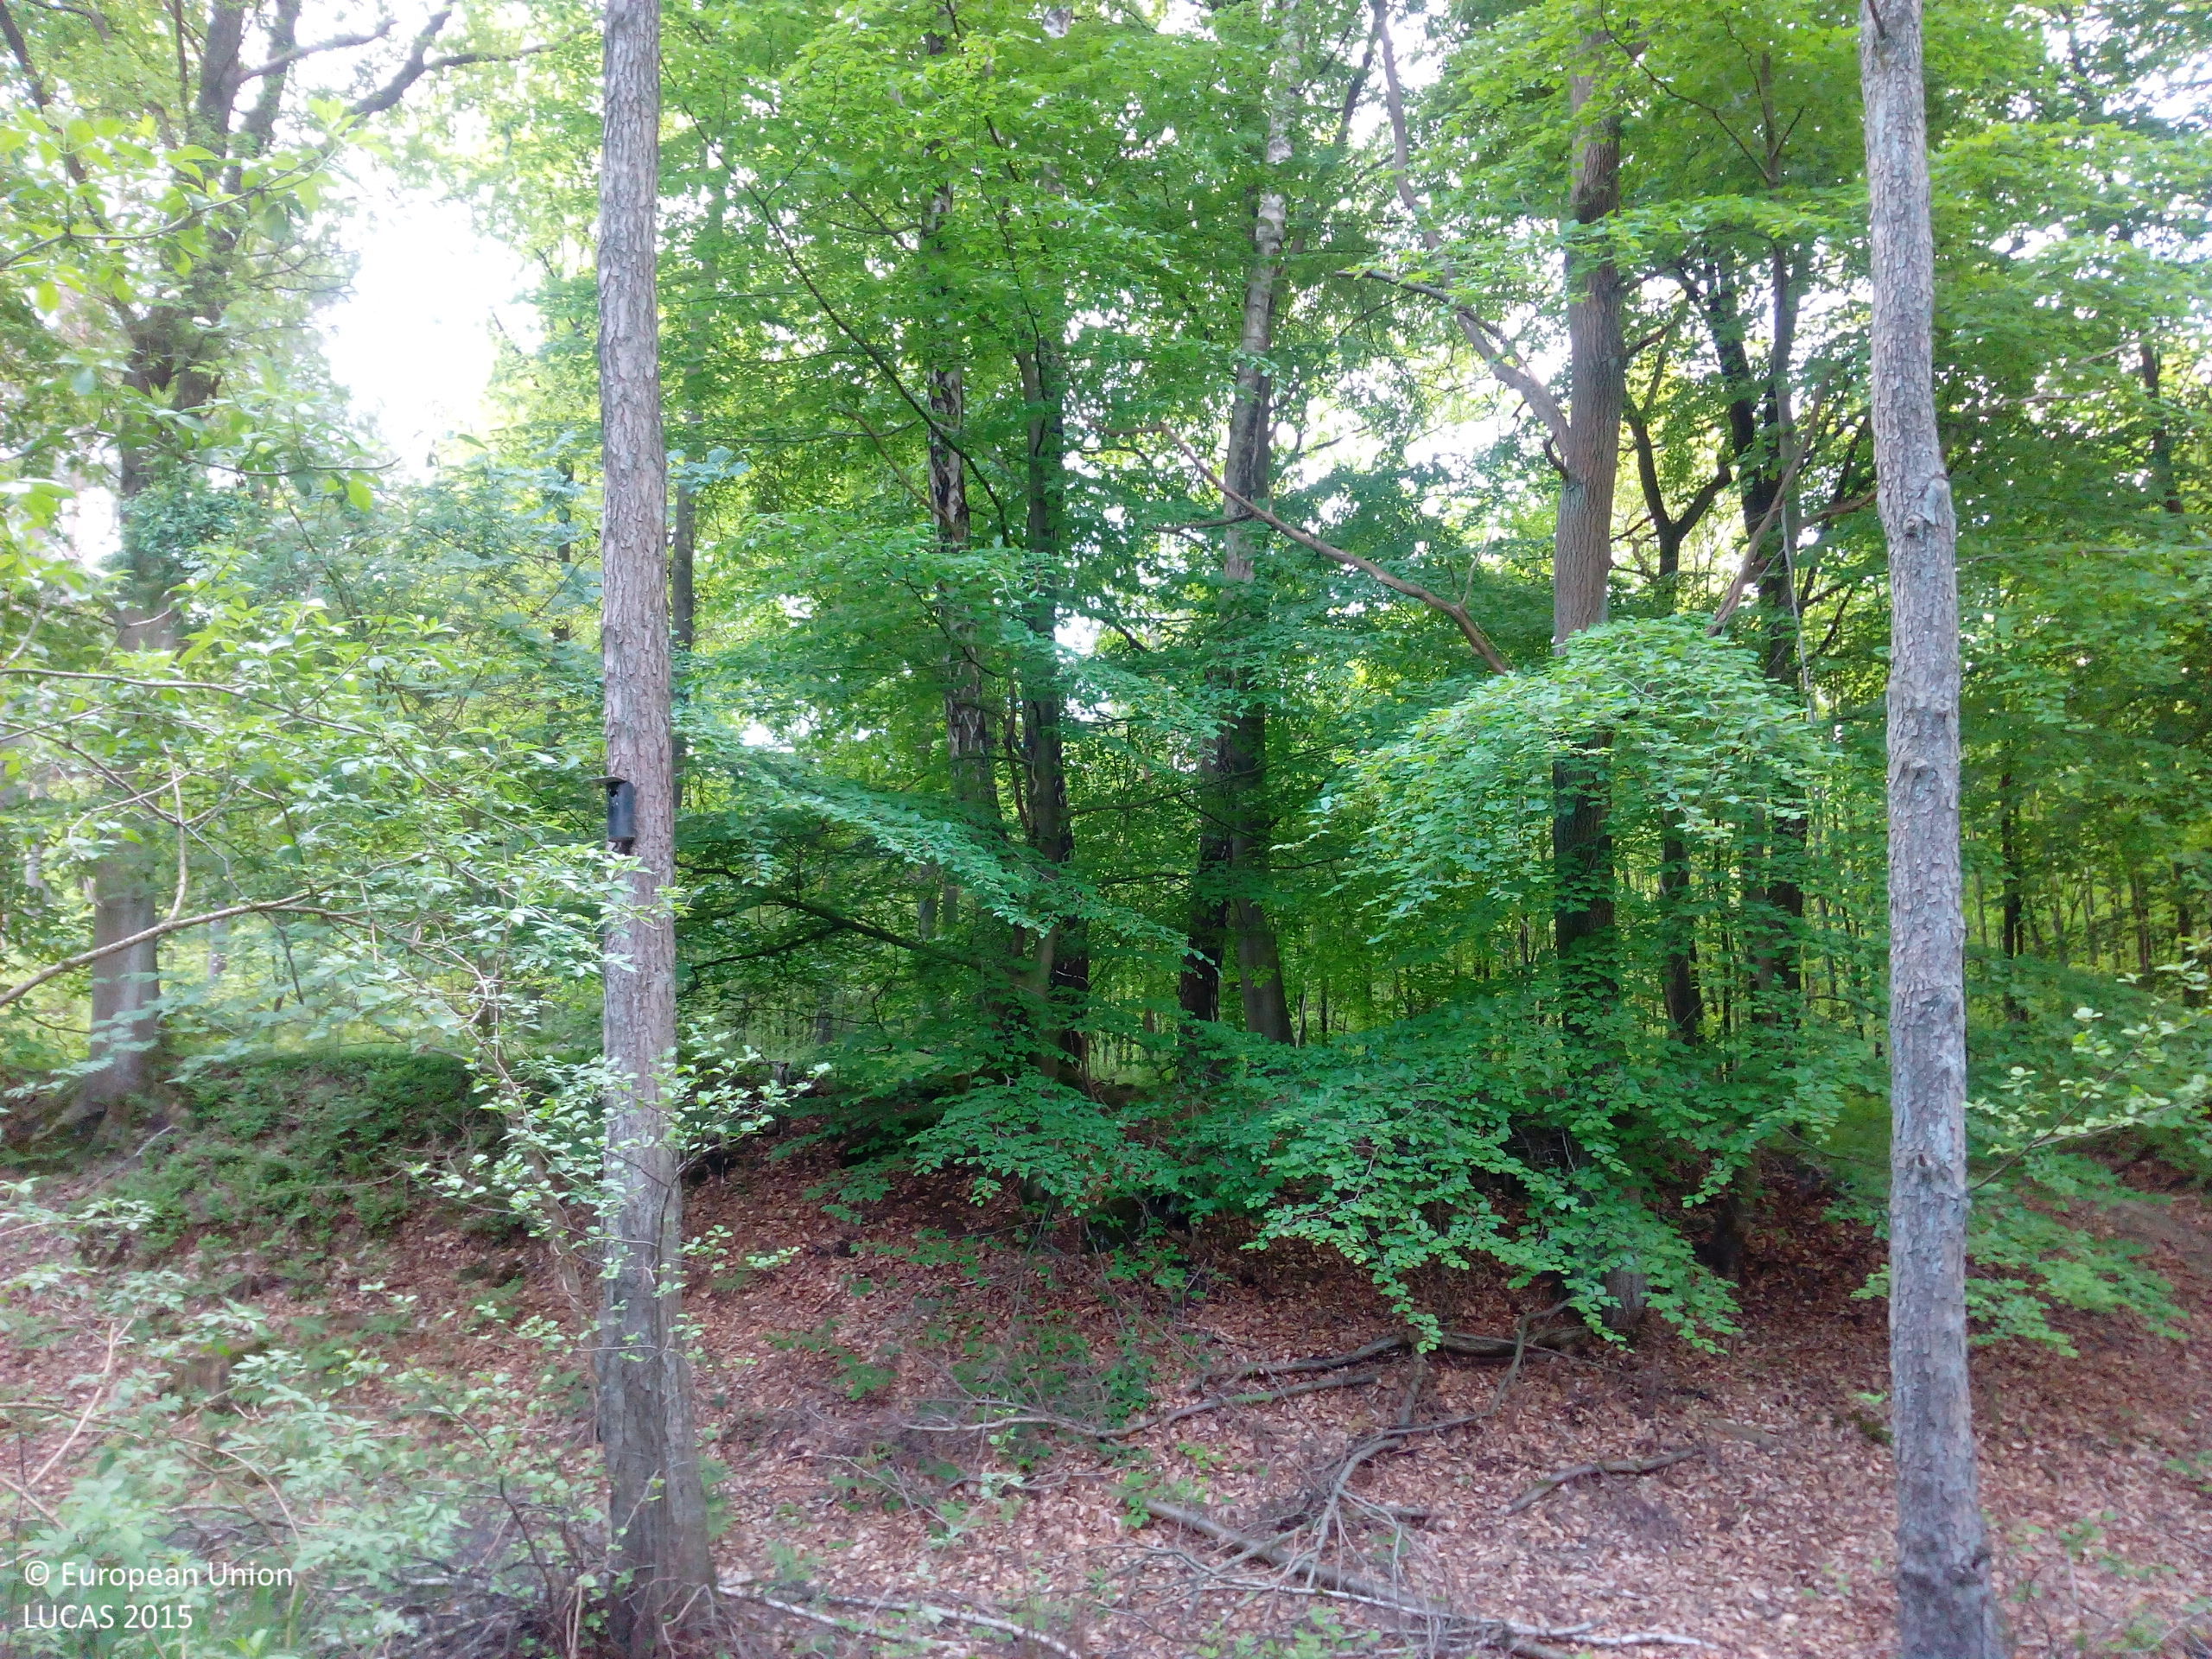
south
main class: Woodland
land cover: Other mixed woodland
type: mire and swamp forests
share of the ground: > 75 %
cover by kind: coniferous forest trees 45 %, broadleaved forest trees 40 %, herbaceous plants 10 %, shrubs 5 %
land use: Forestry
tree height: > 5 m
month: May
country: DE
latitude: 52.2240
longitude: 7.4385
